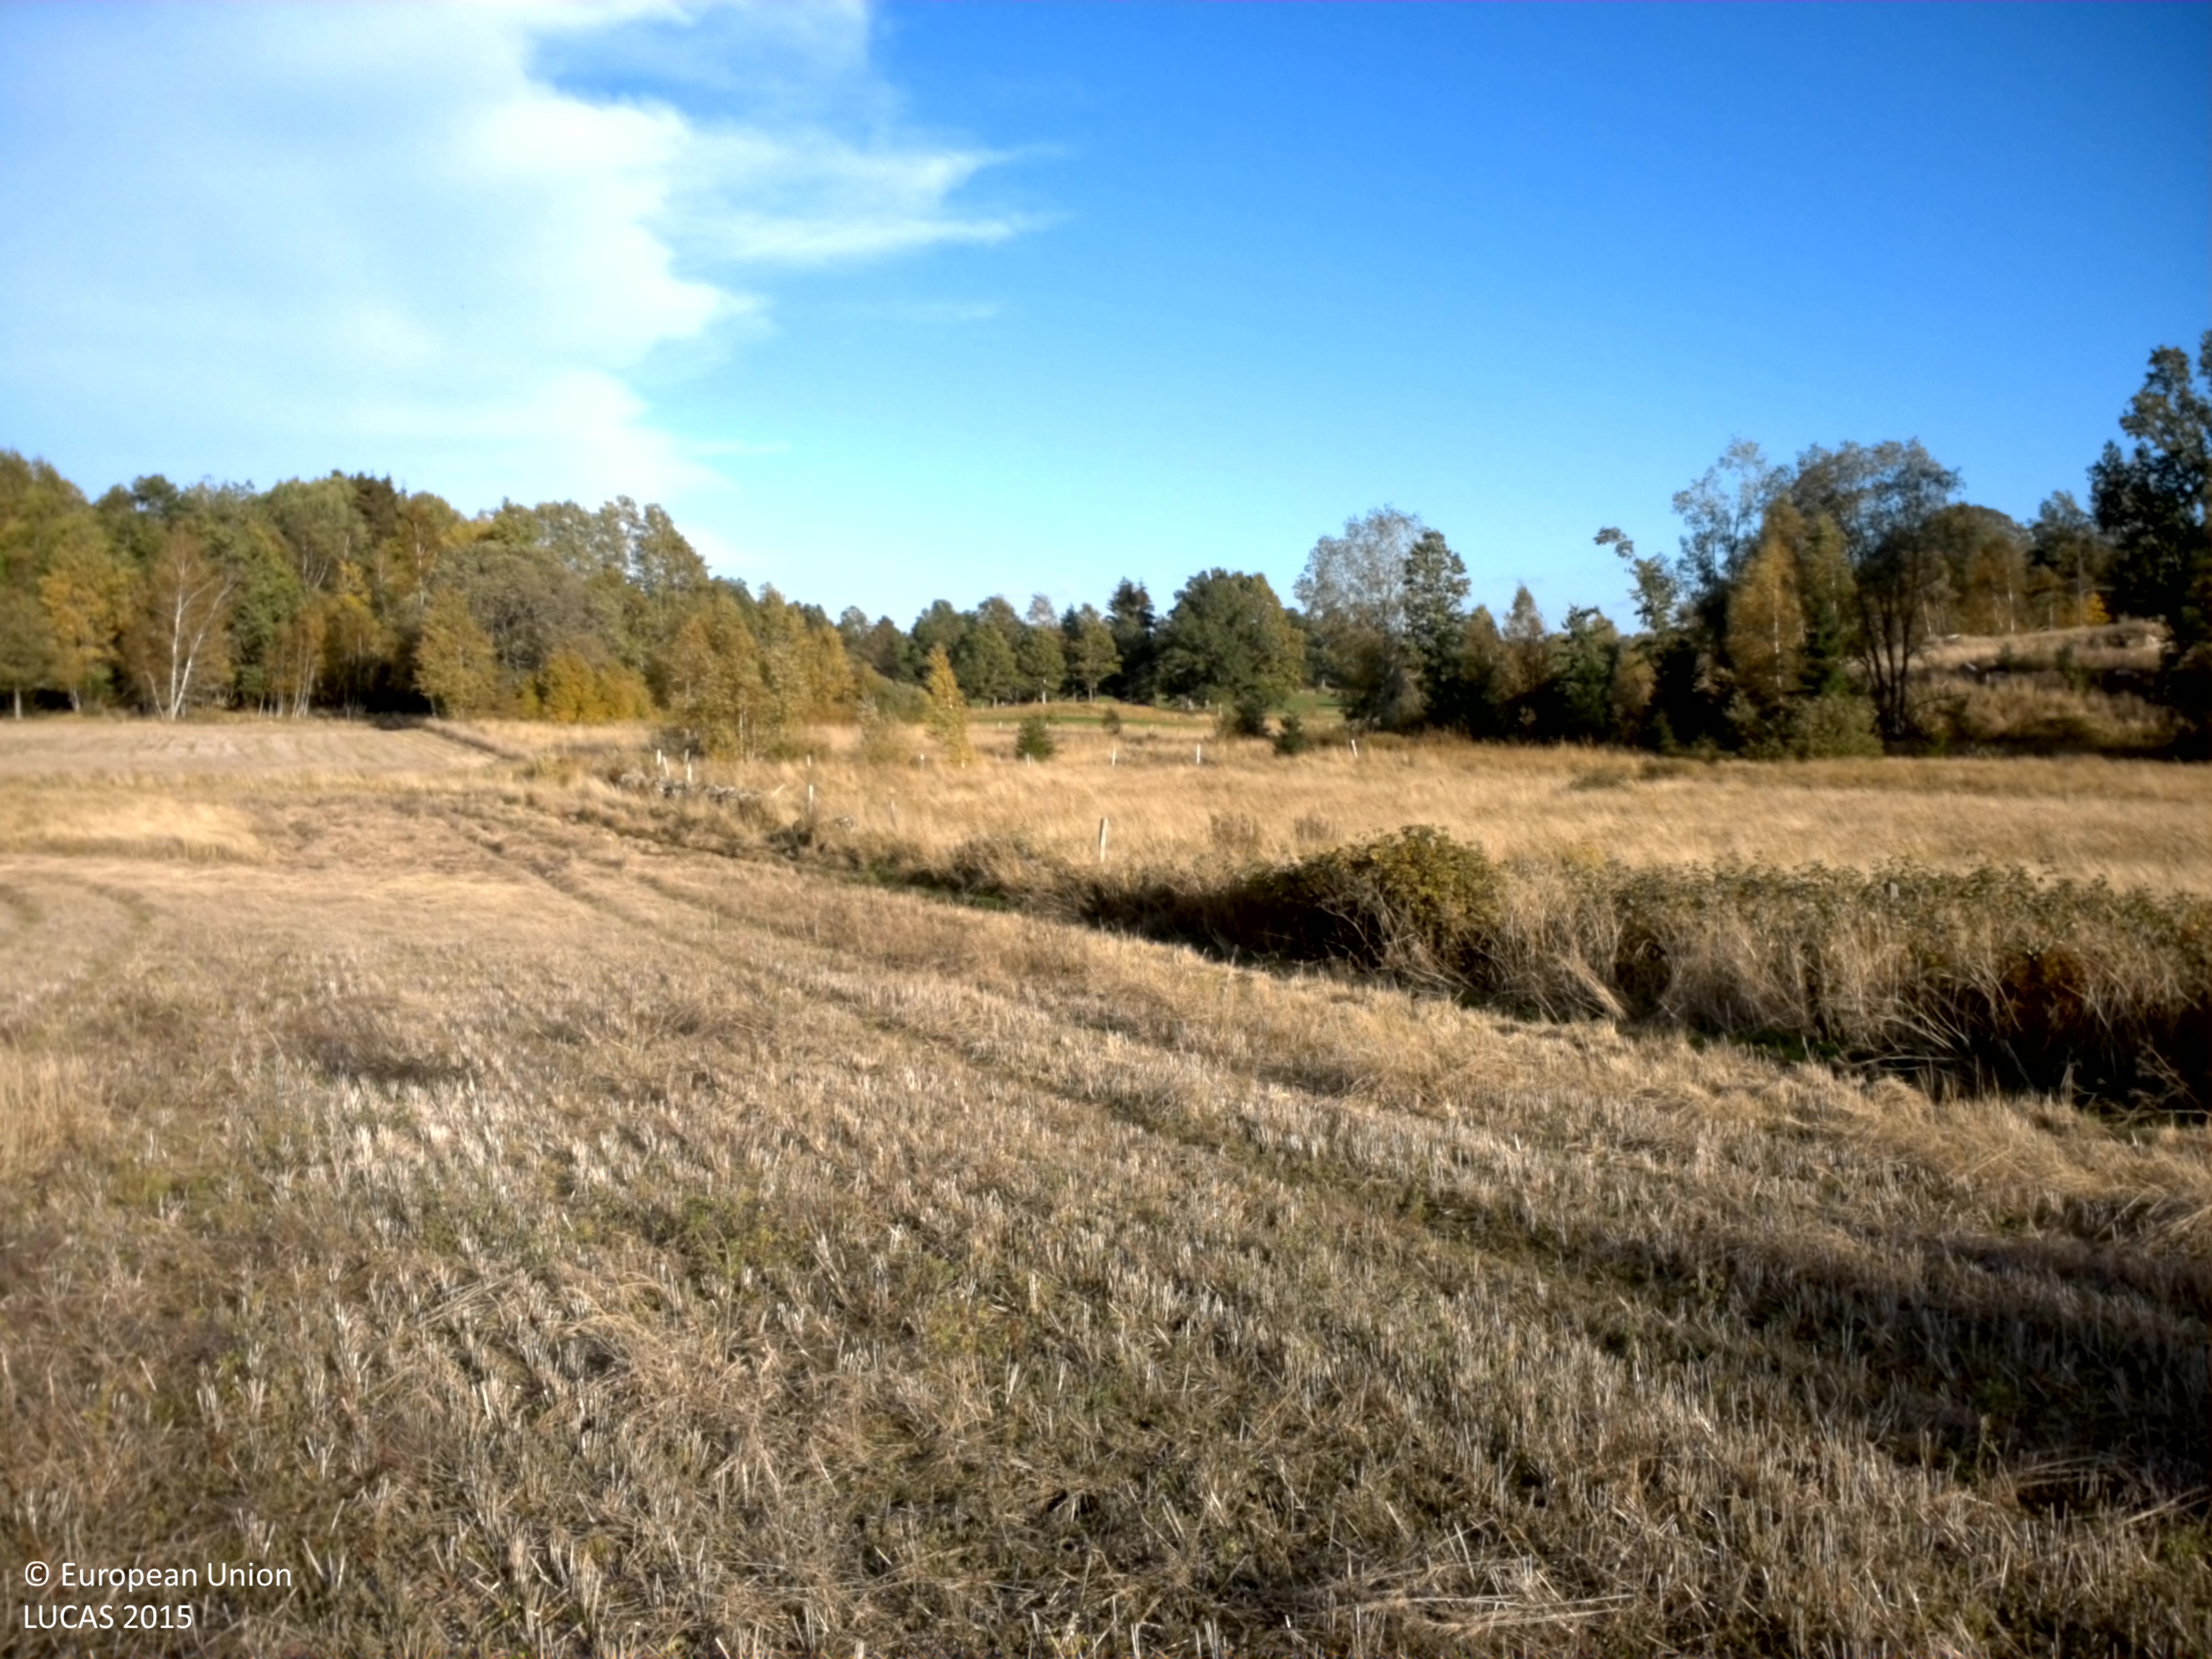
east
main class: Cropland
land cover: Other fibre and oleaginous crops
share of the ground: > 75 %
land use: Agriculture (excluding fallow land and kitchen gardens)
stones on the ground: < 10 %
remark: Harvested field
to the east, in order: Other fibre and oleaginous crops; Dry stone walls; Shruby margins; Grassland without tree/shrub cover; Fences; Grassland without tree/shrub cover; Ditches and canals; Grassland without tree/shrub cover; Dry stone walls; Grassland without tree/shrub cover; Grassland with sparse tree/shrub cover
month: October
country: SE
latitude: 58.1492
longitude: 13.0361
